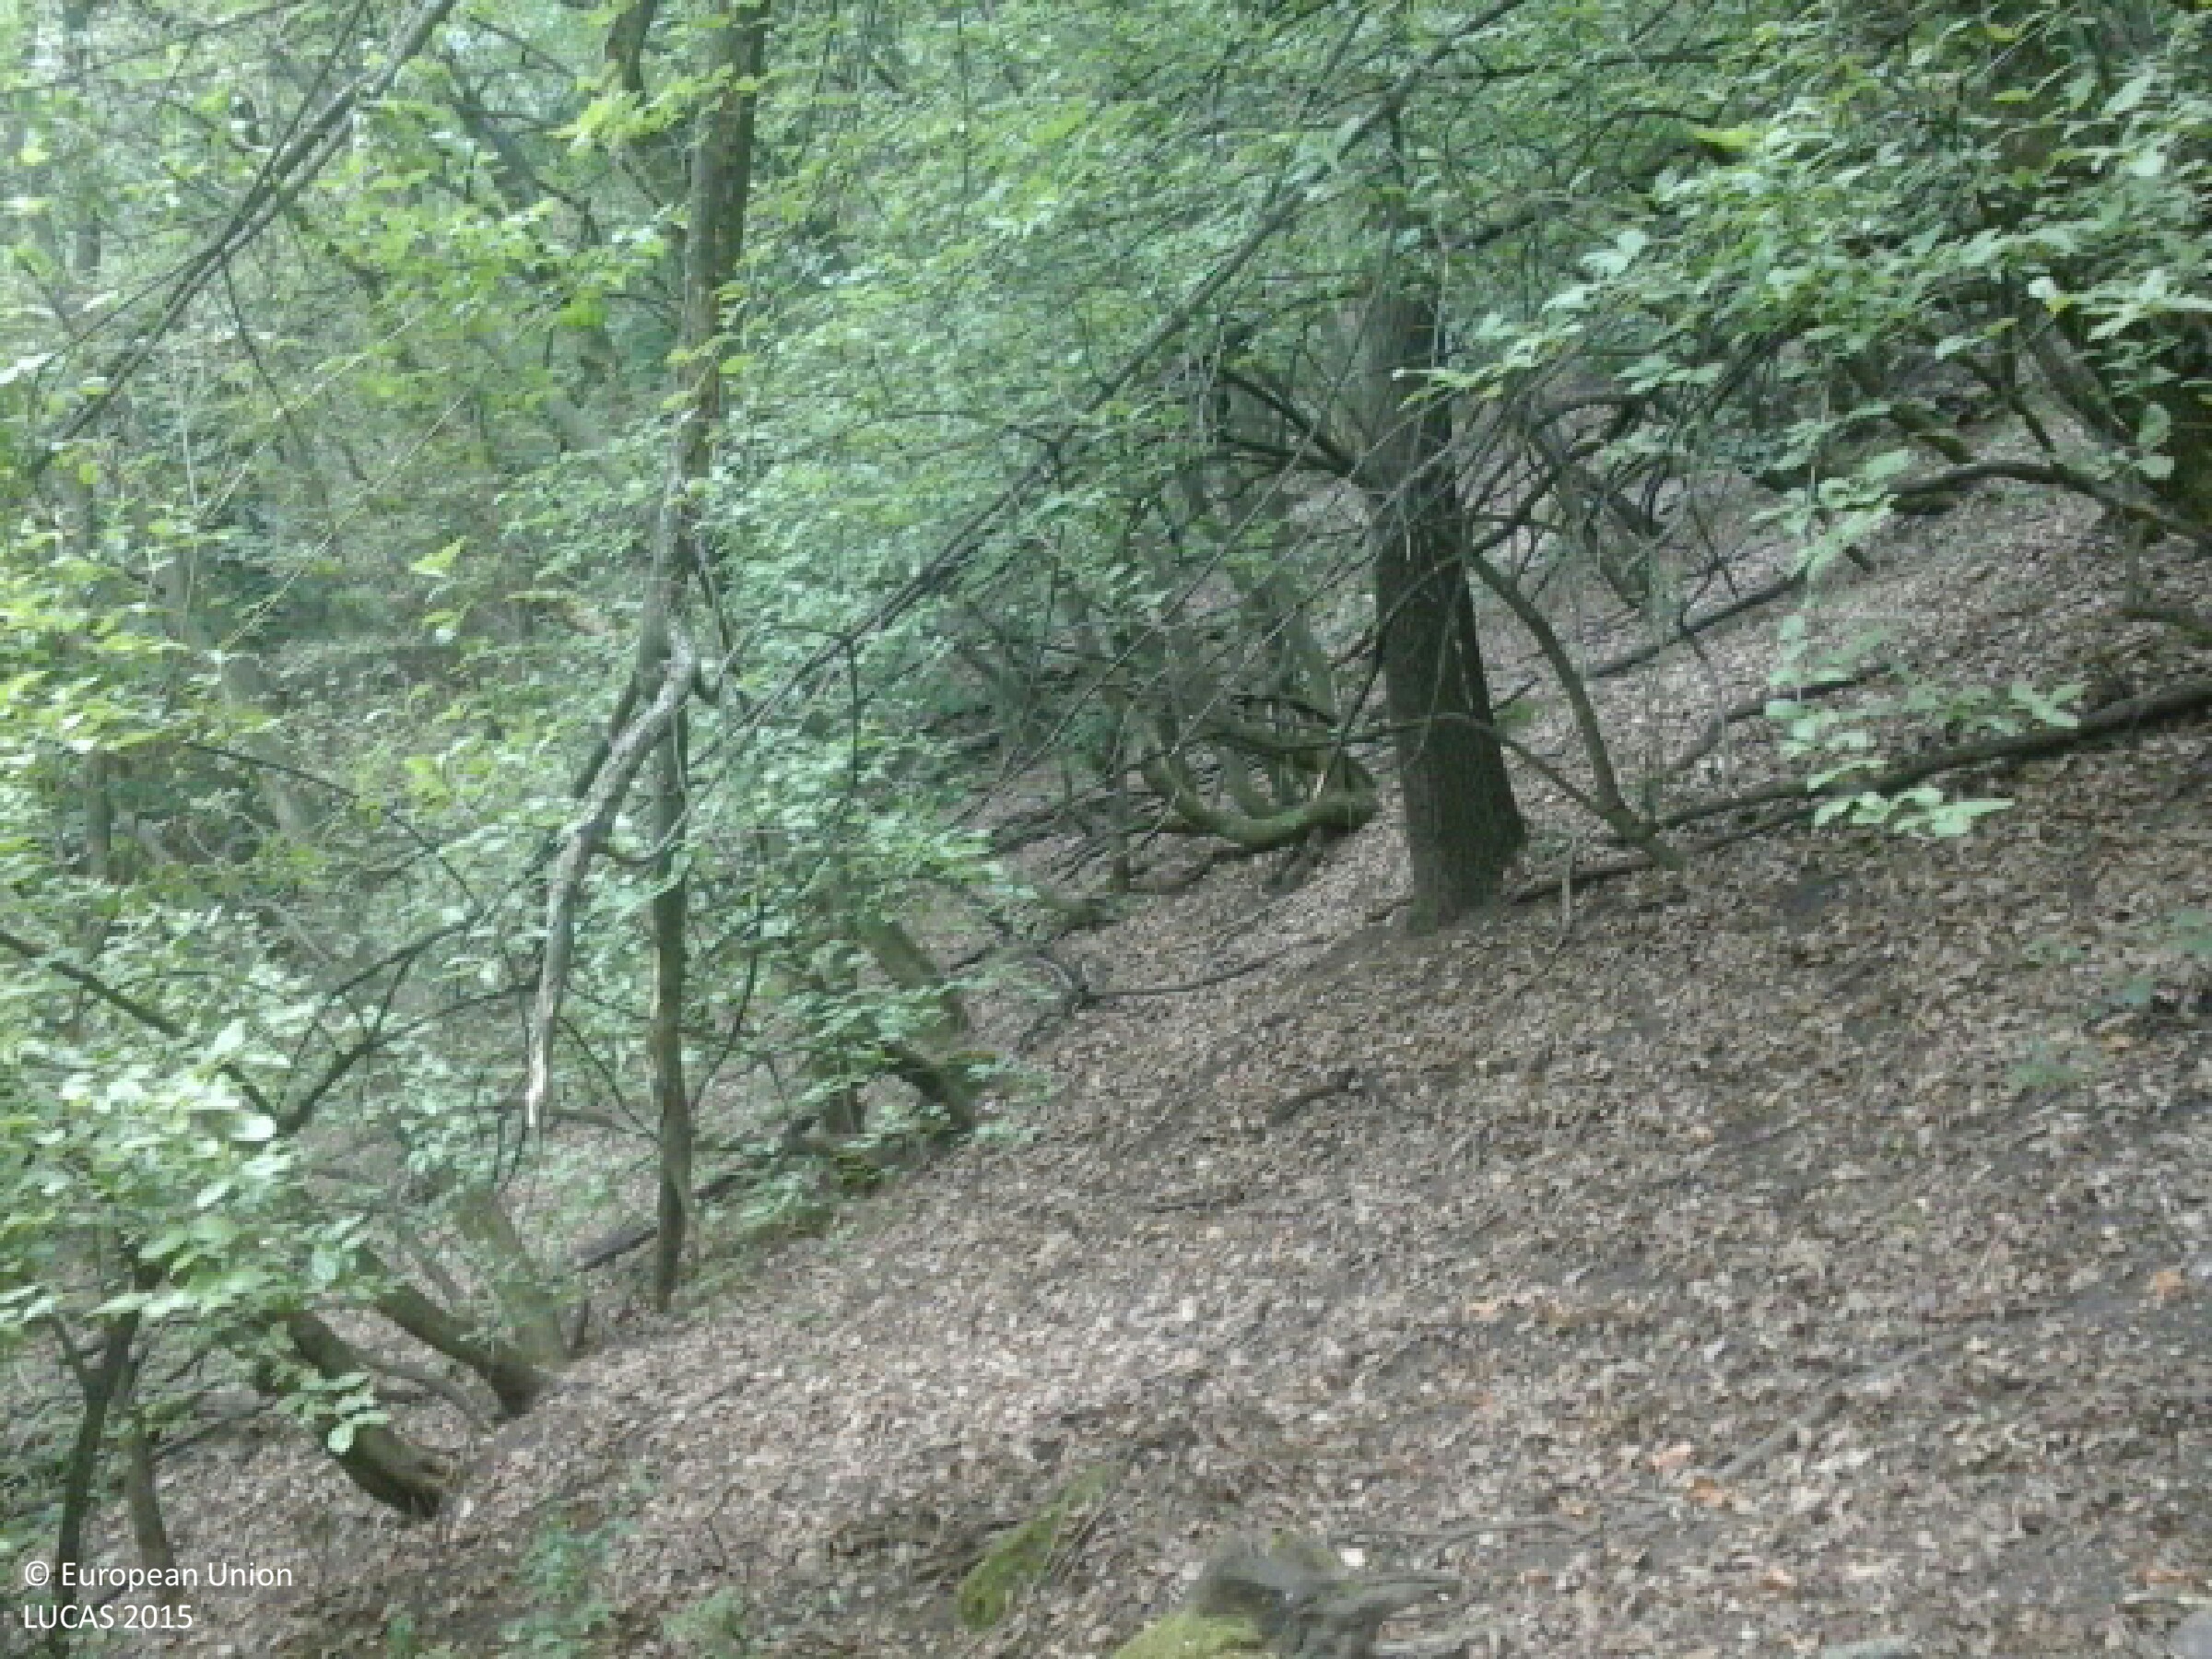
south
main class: Woodland
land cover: Broadleaved woodland
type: mesophytic deciduous forest
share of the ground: > 75 %
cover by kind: broadleaved forest trees 95 %, unconsolidated bare surface 5 %
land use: Forestry
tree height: > 5 m
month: June
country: HU
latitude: 47.7043
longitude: 19.0676
